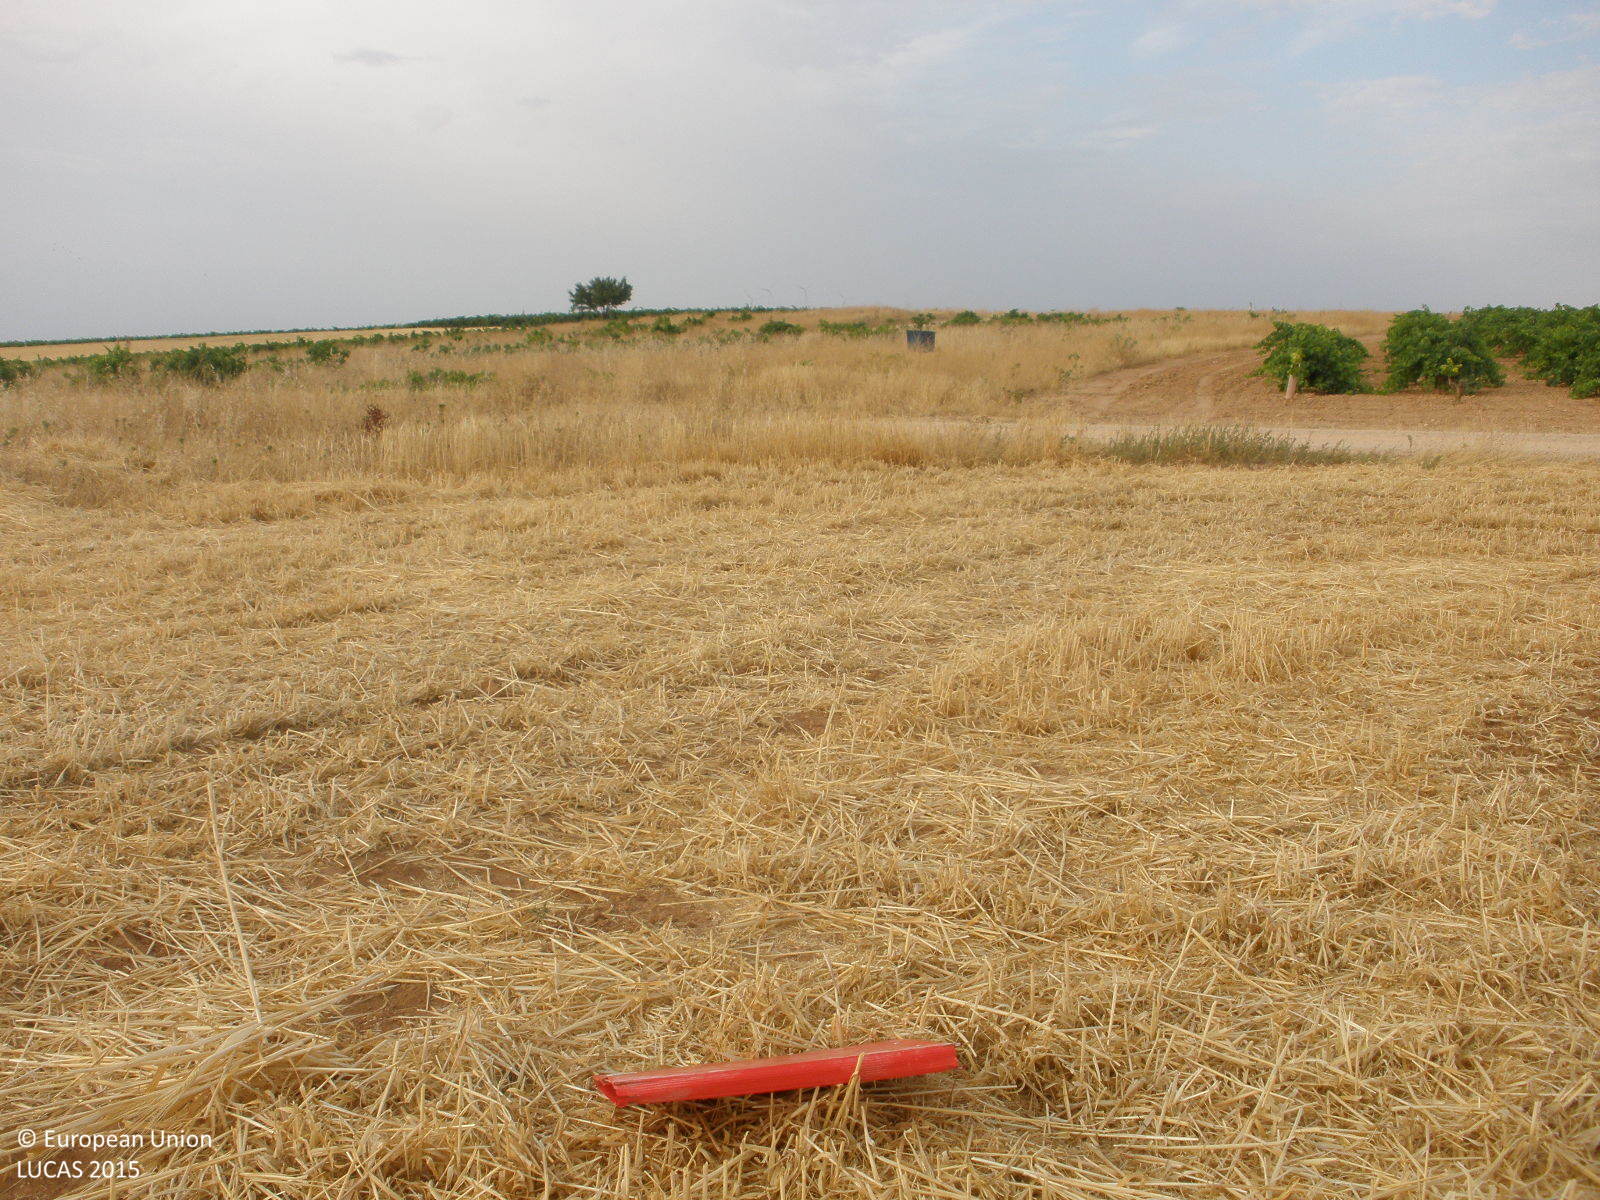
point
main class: Cropland
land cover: Barley
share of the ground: < 10 %
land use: Agriculture (excluding fallow land and kitchen gardens)
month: July
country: ES
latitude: 39.7996
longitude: -3.2801
